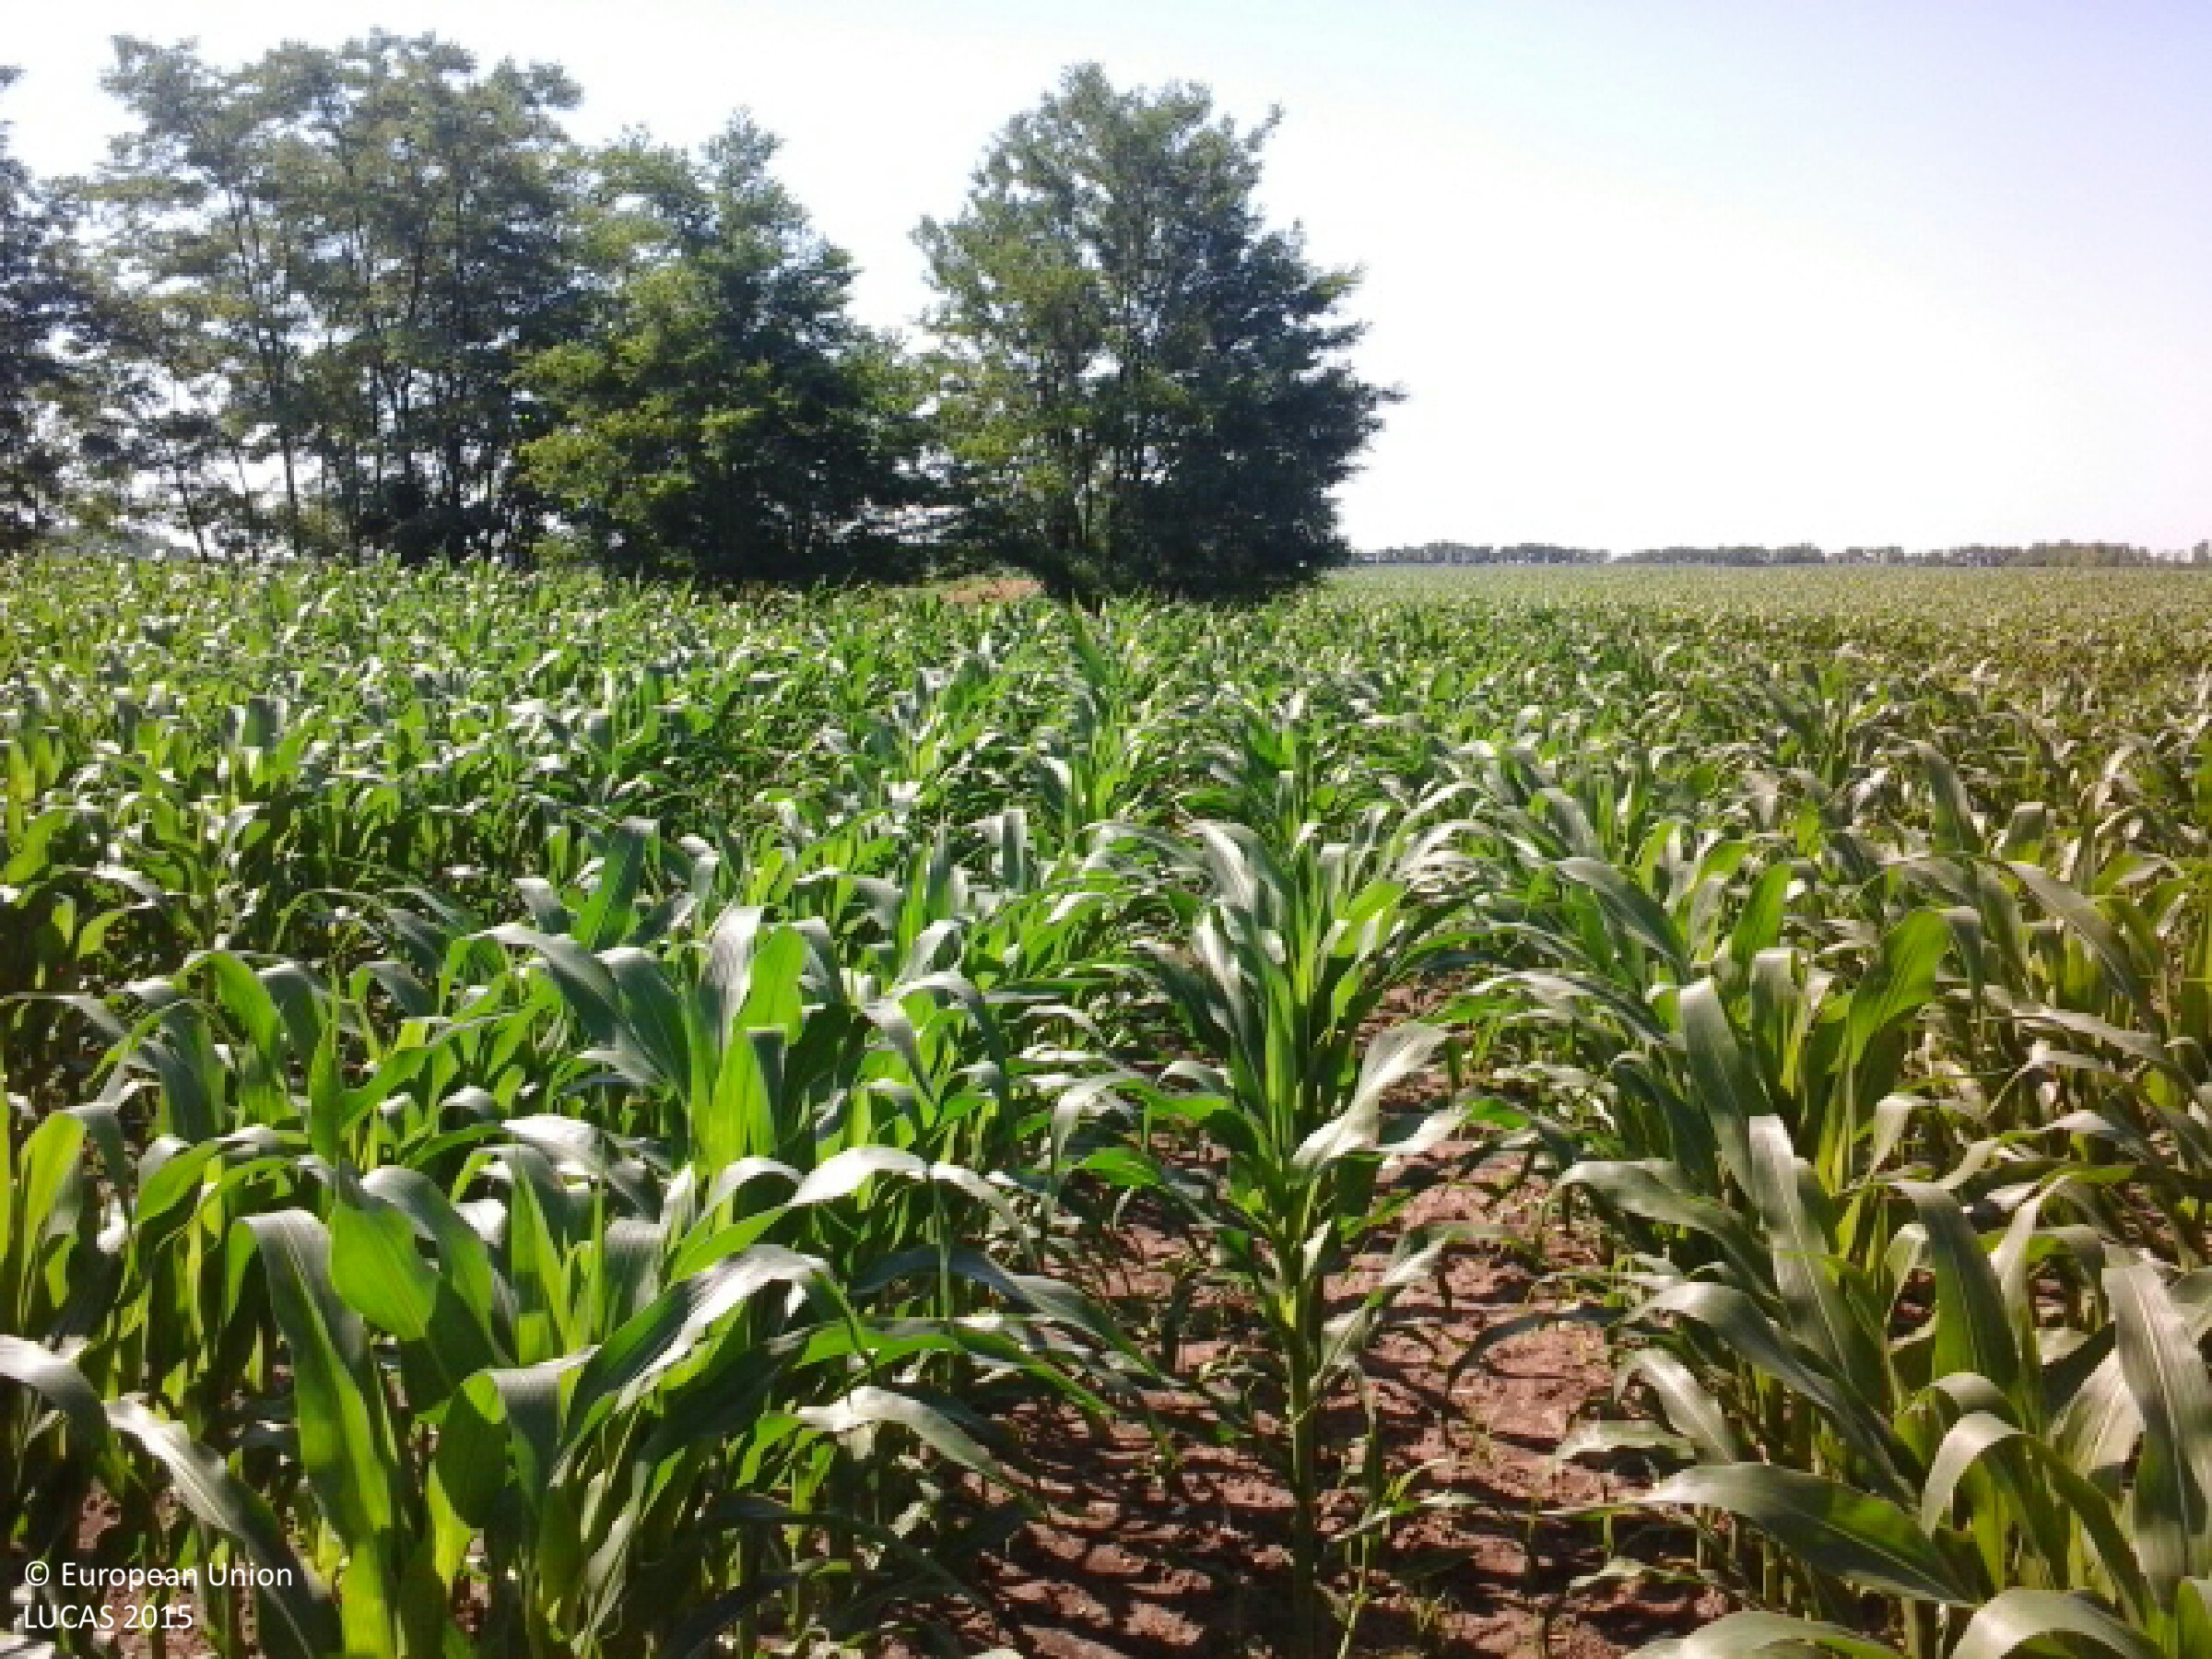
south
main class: Cropland
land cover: Maize
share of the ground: 50 - 75 %
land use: Agriculture (excluding fallow land and kitchen gardens)
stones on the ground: < 10 %
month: June
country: HU
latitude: 47.7950
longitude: 21.7285
